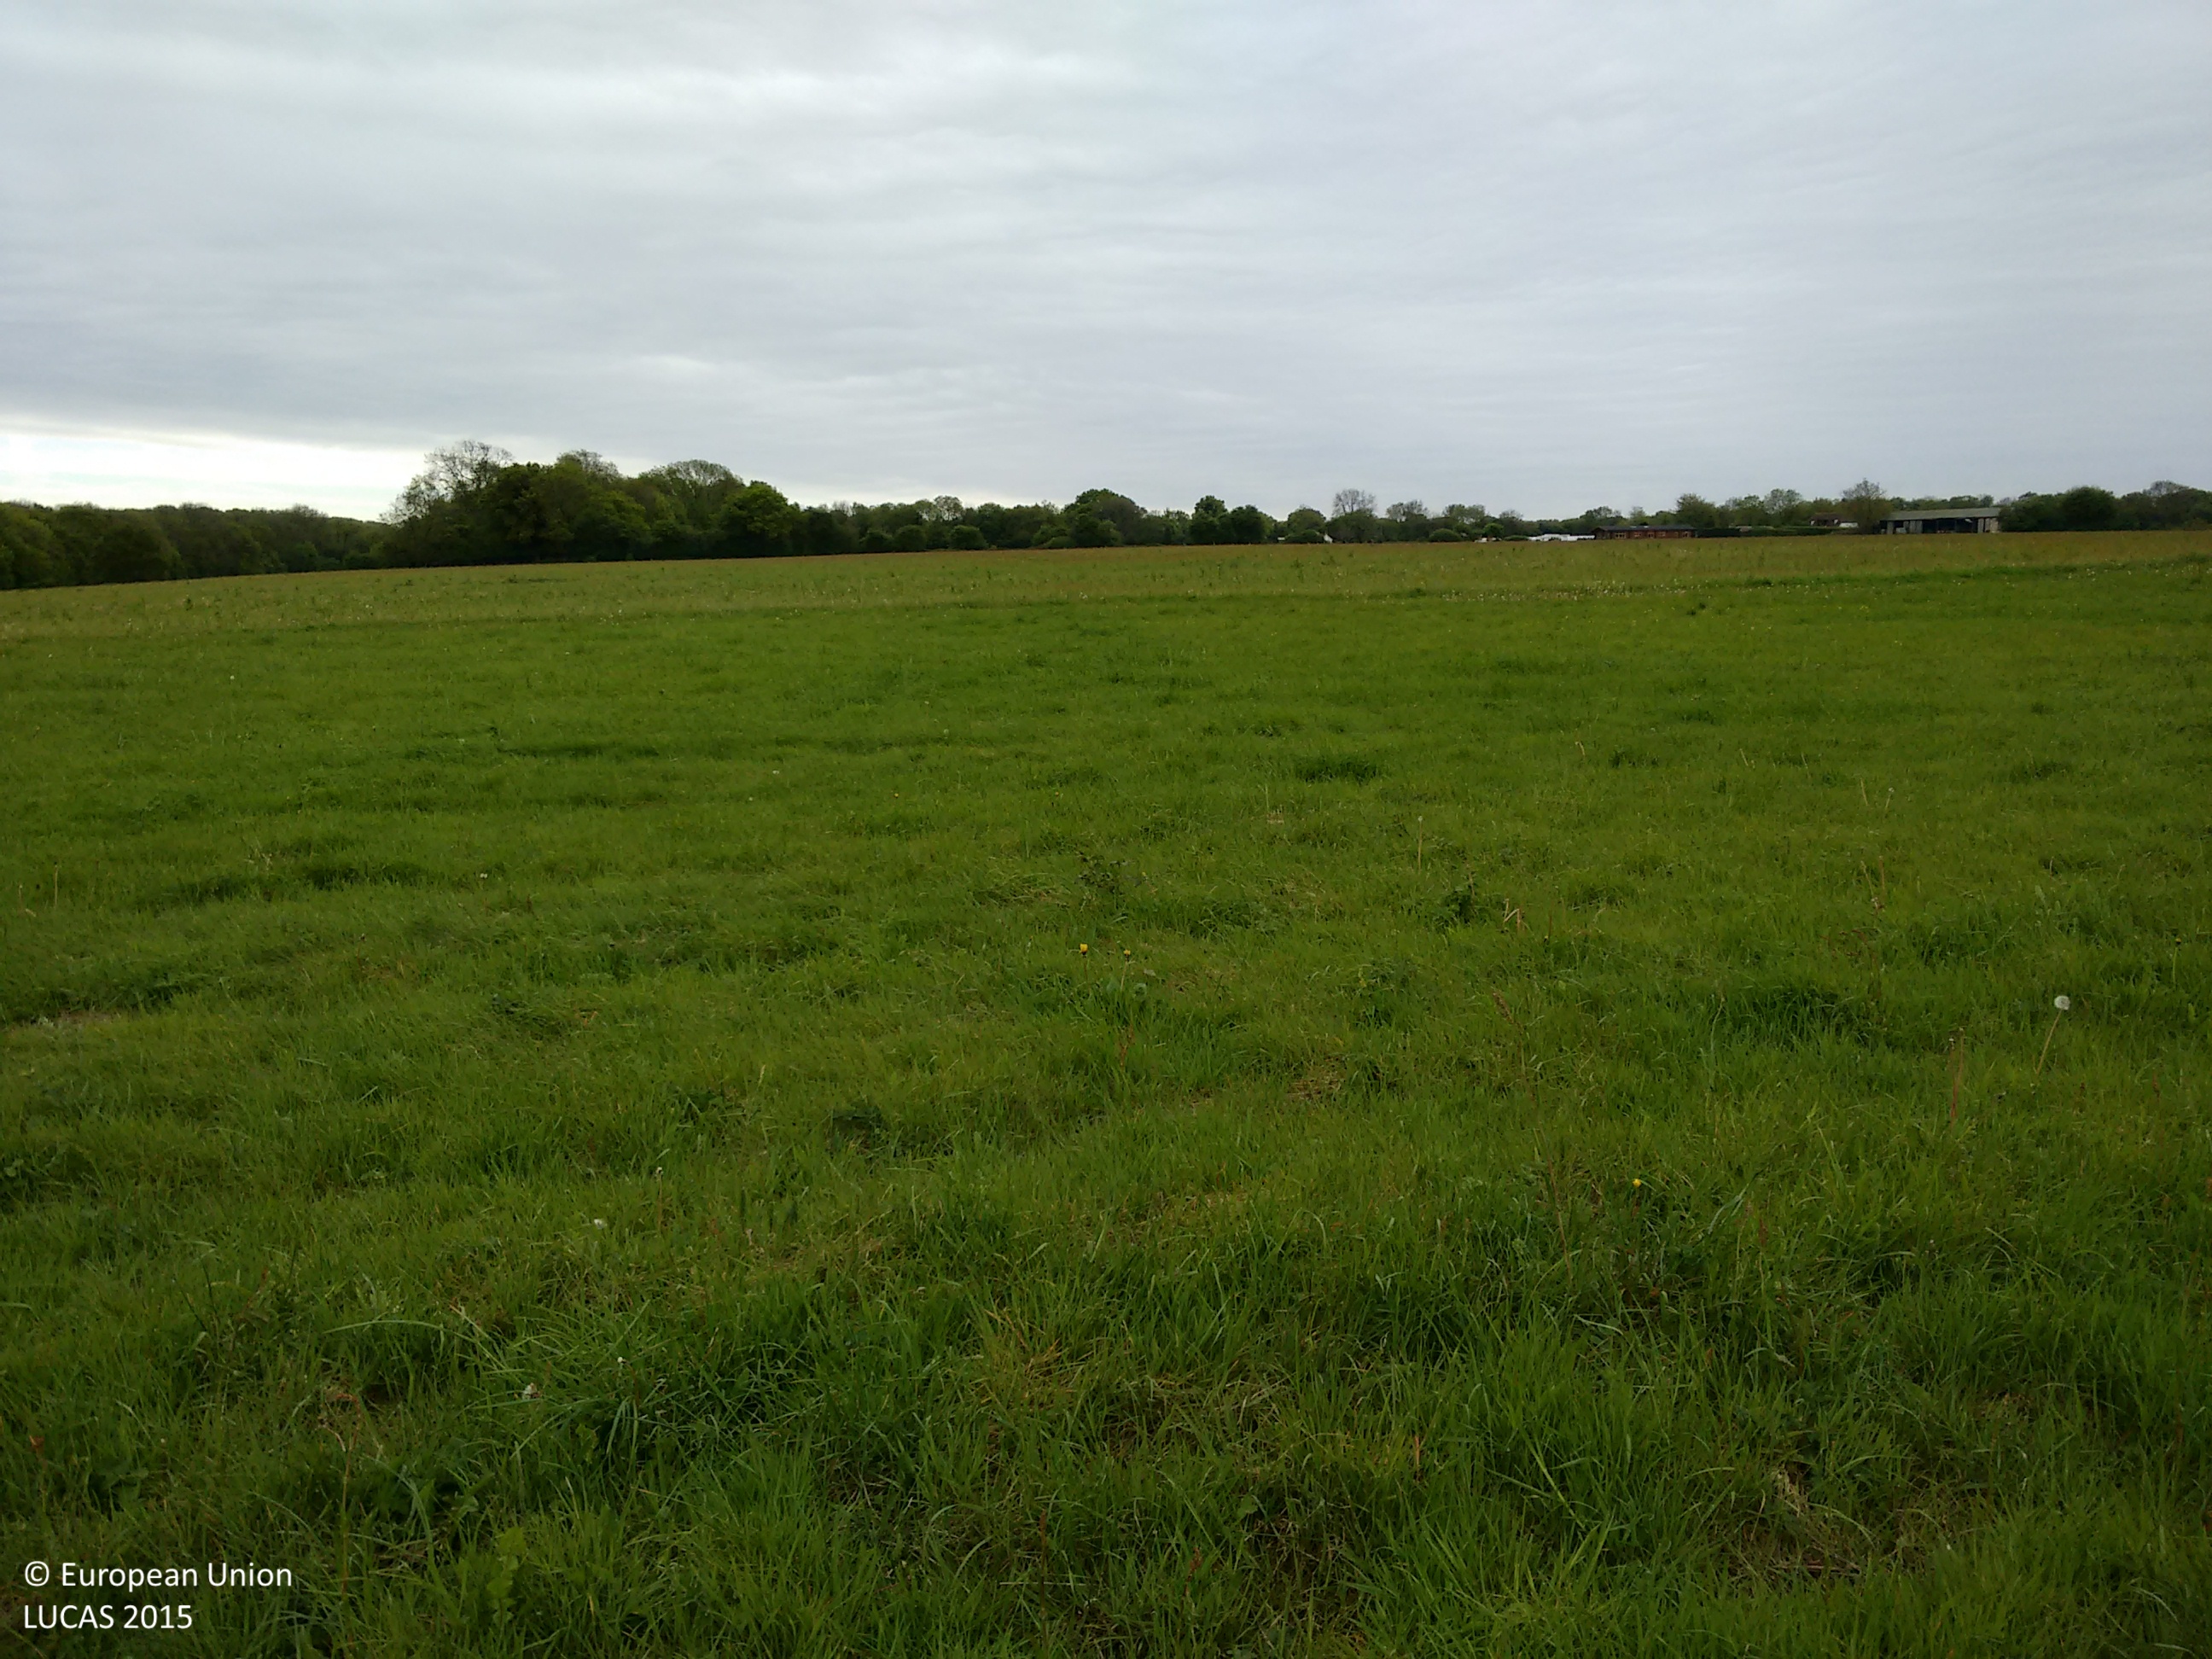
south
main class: Grassland
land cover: Grassland without tree/shrub cover
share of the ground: > 75 %
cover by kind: herbaceous plants 100 %
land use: Agriculture (excluding fallow land and kitchen gardens)
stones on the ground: < 10 %
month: May
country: GB
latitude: 51.3663
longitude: 0.3327
